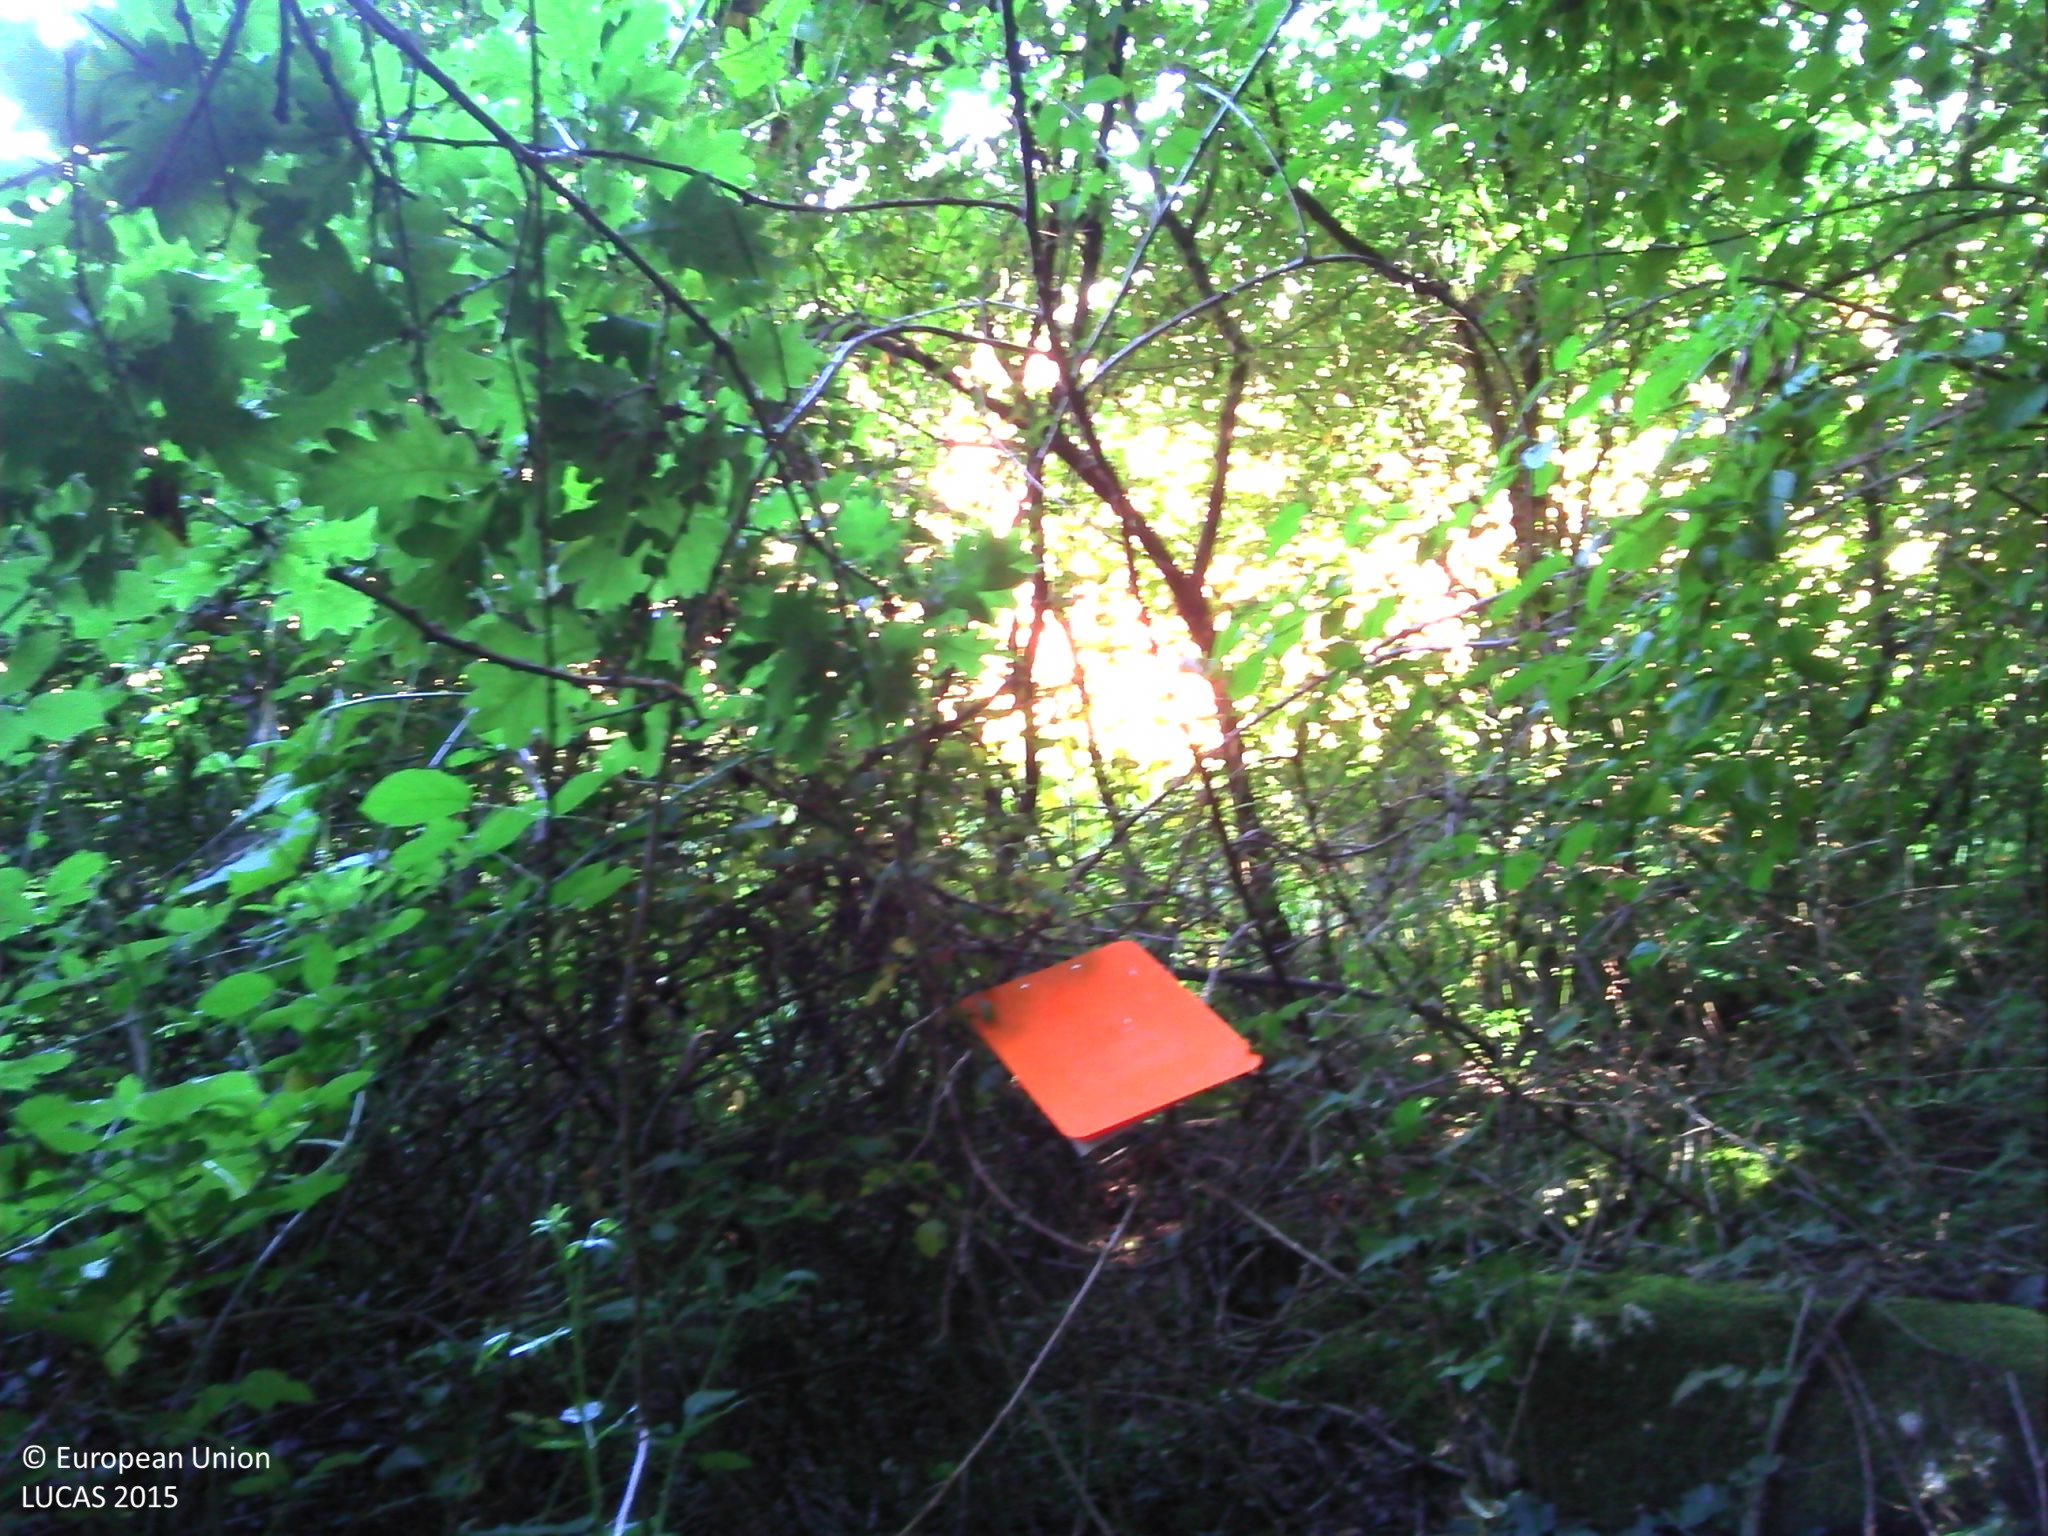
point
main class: Woodland
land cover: Broadleaved woodland
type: boreal forest
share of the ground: > 75 %
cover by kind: broadleaved forest trees 90 %, herbaceous plants 10 %
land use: Semi-natural and natural areas not in use
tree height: > 5 m
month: June
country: FR
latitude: 45.6132
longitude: 0.4326
